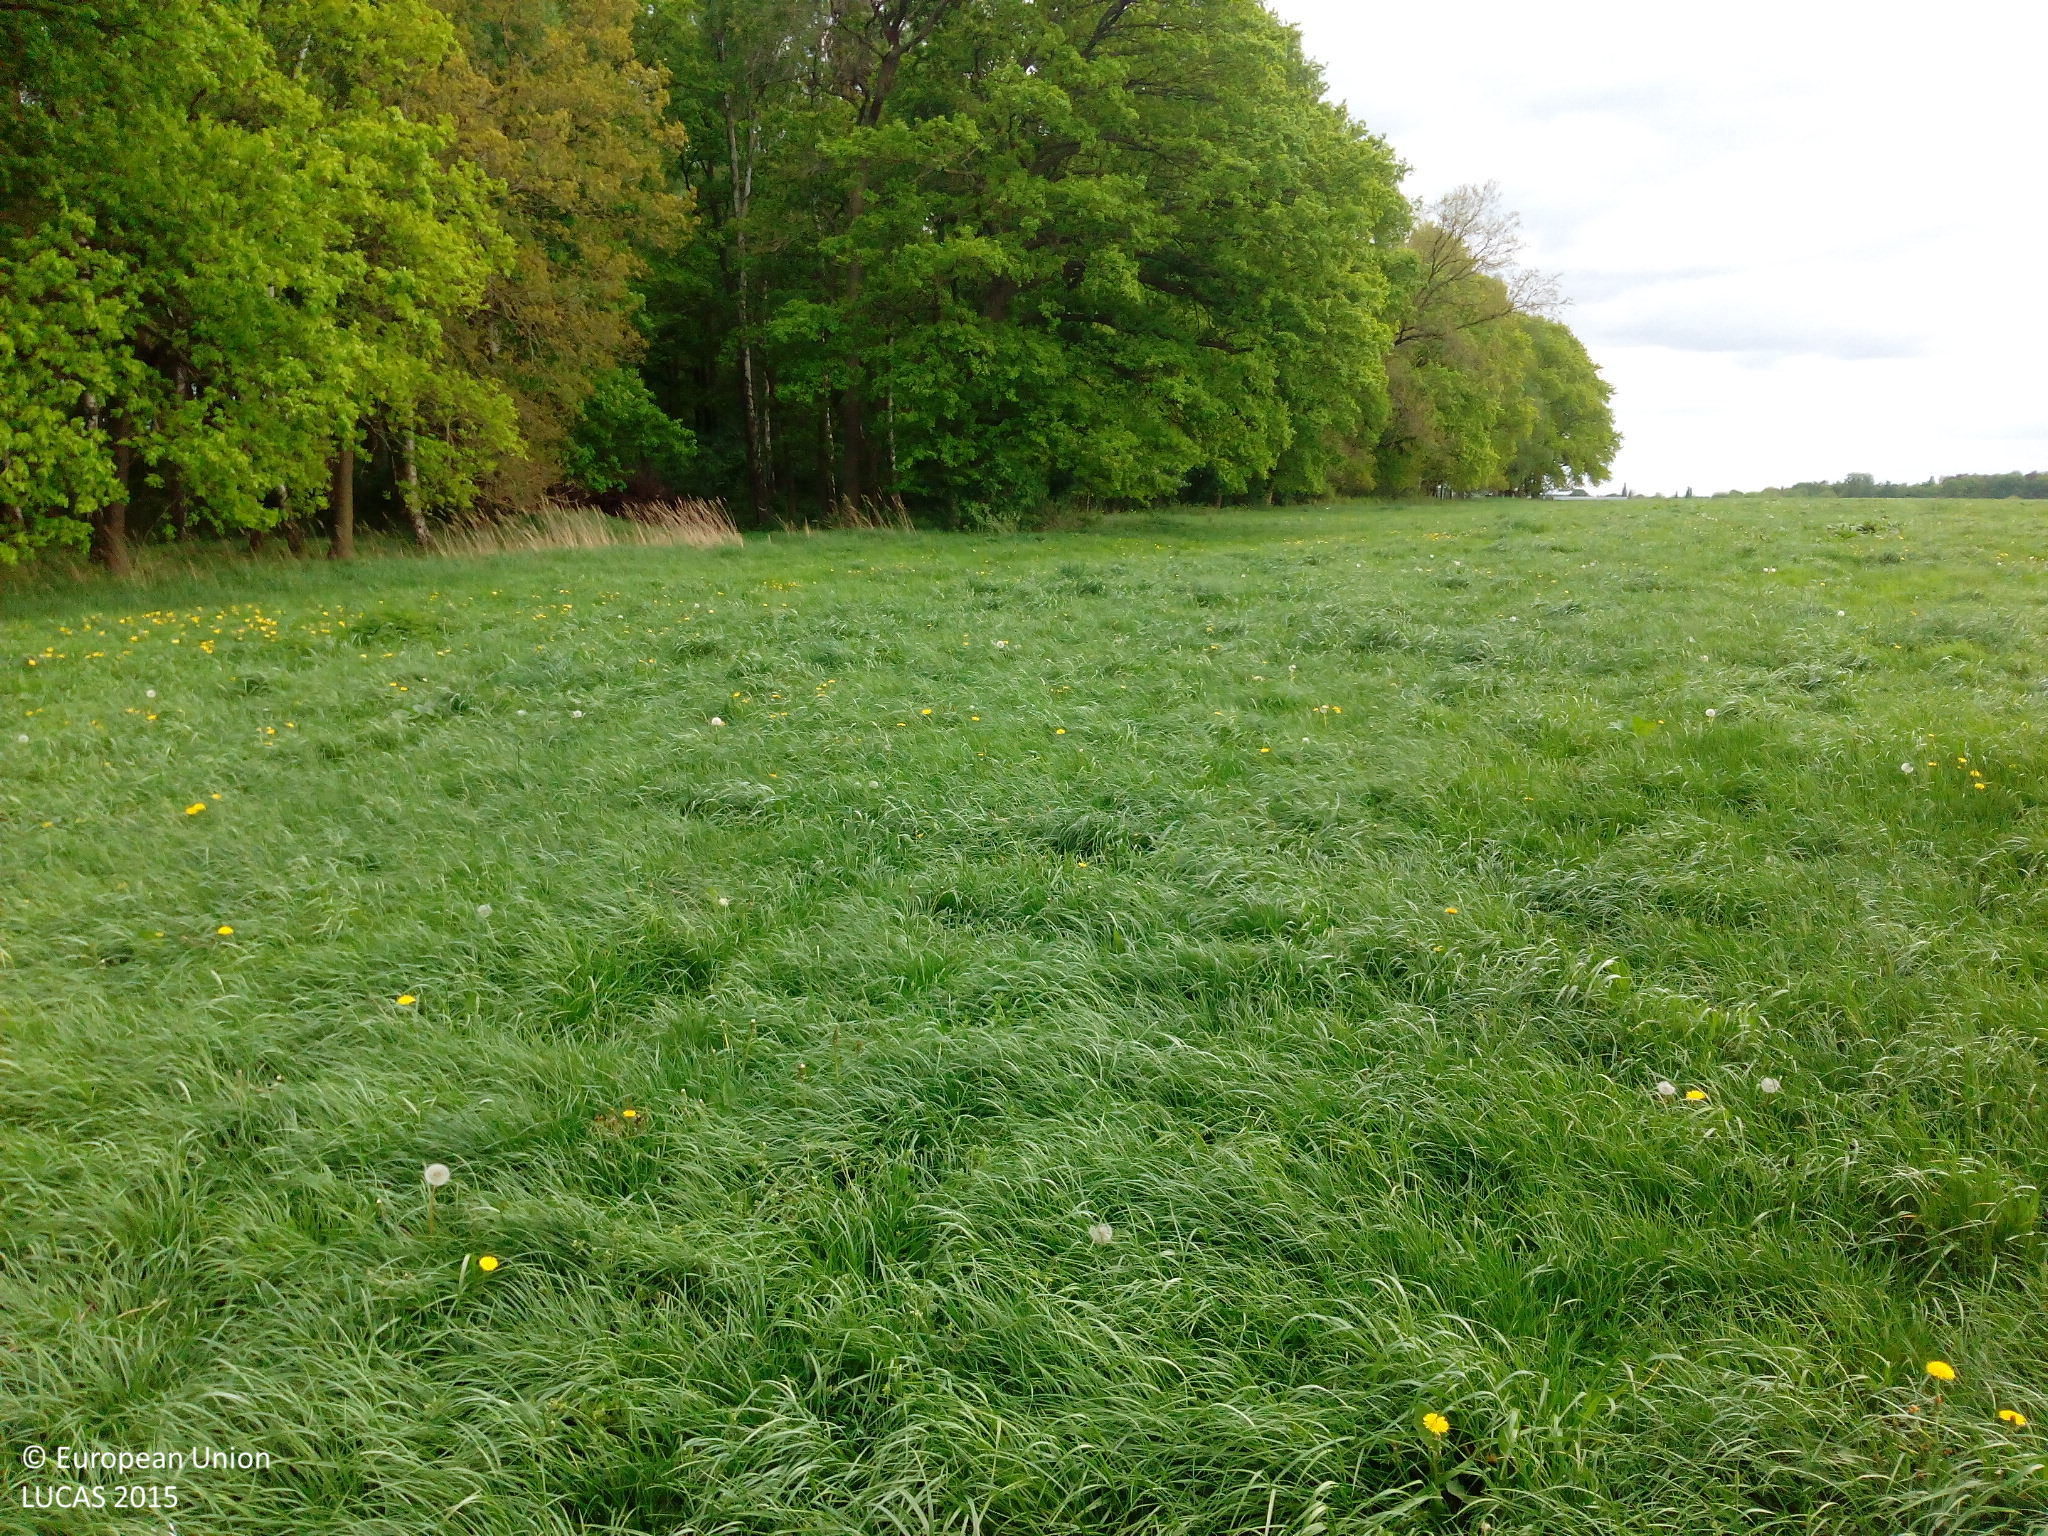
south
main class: Grassland
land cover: Grassland without tree/shrub cover
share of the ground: > 75 %
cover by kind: herbaceous plants 100 %
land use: Agriculture (excluding fallow land and kitchen gardens)
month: May
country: DE
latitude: 52.8518
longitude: 11.6181
